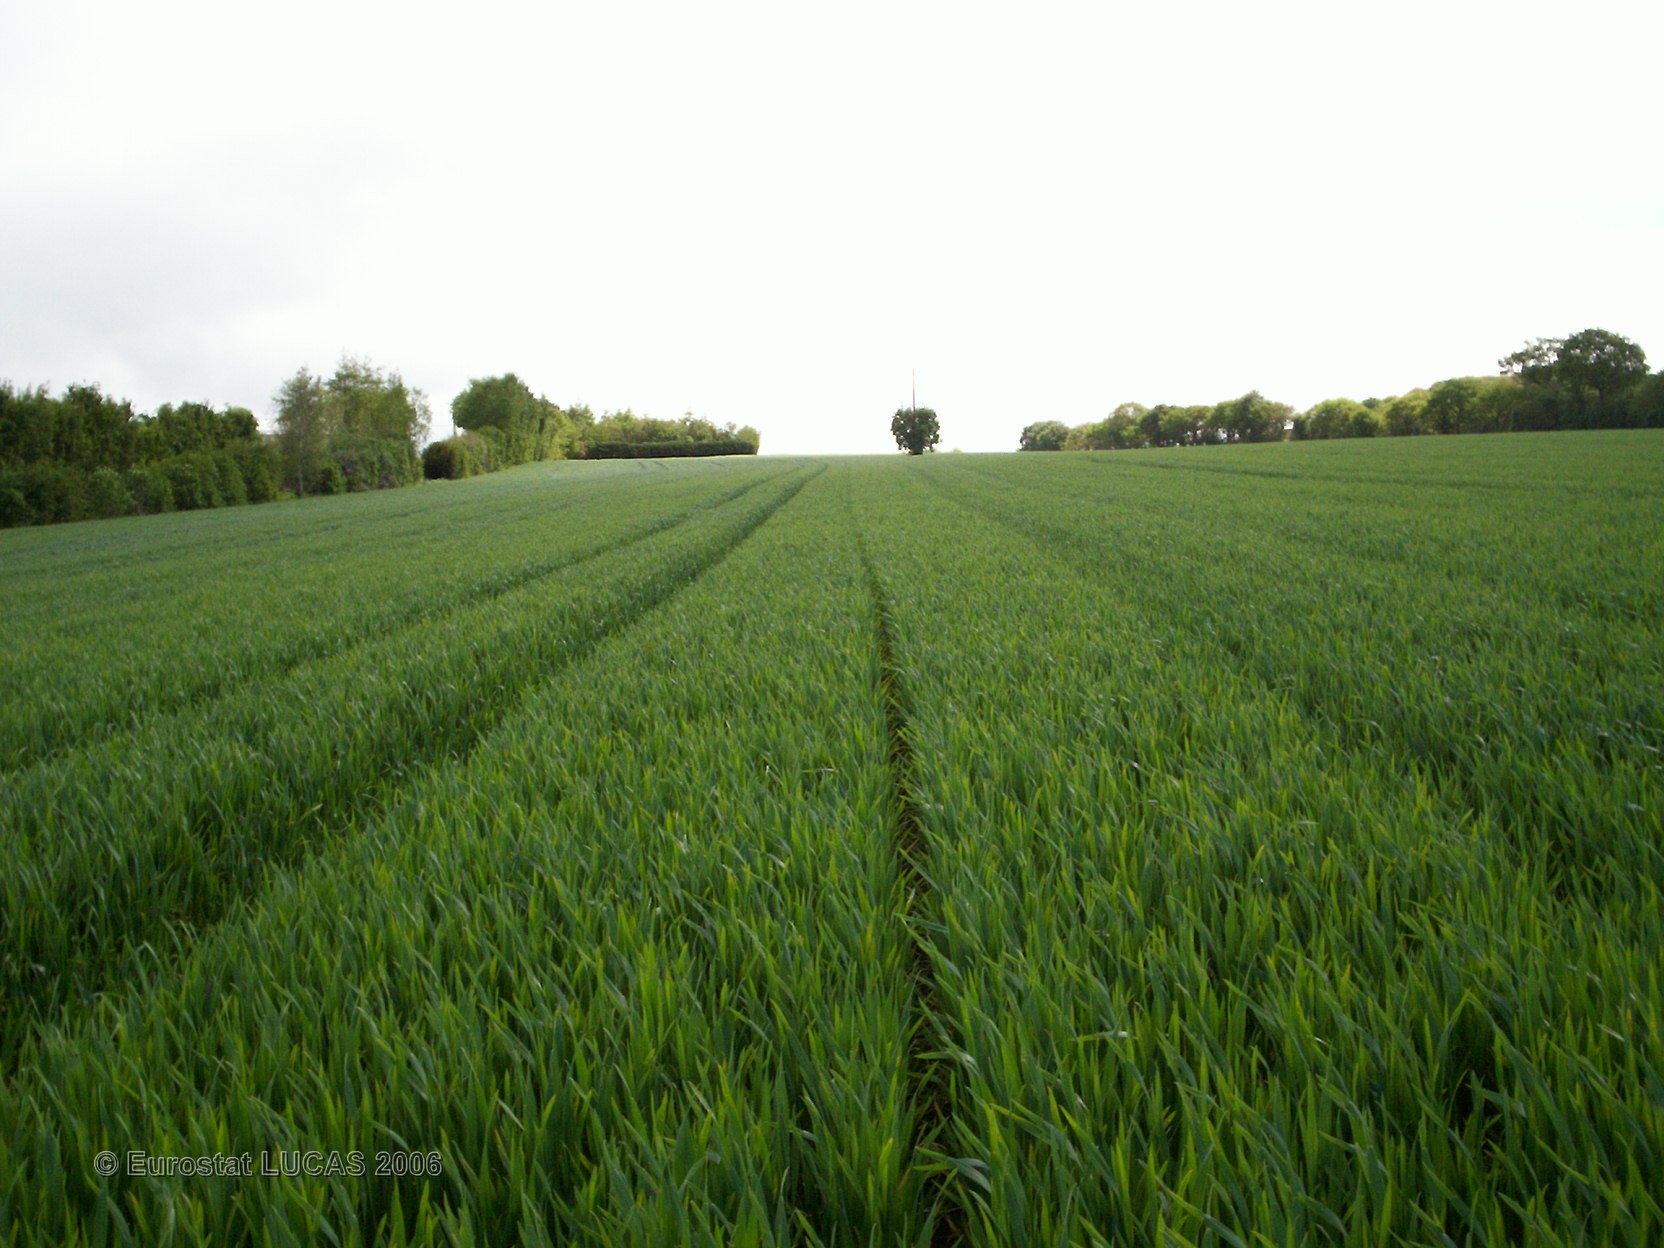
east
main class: Cropland
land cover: Common wheat
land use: Agriculture (excluding fallow land and kitchen gardens)
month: May
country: FR
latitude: 48.2951
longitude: -2.9410
